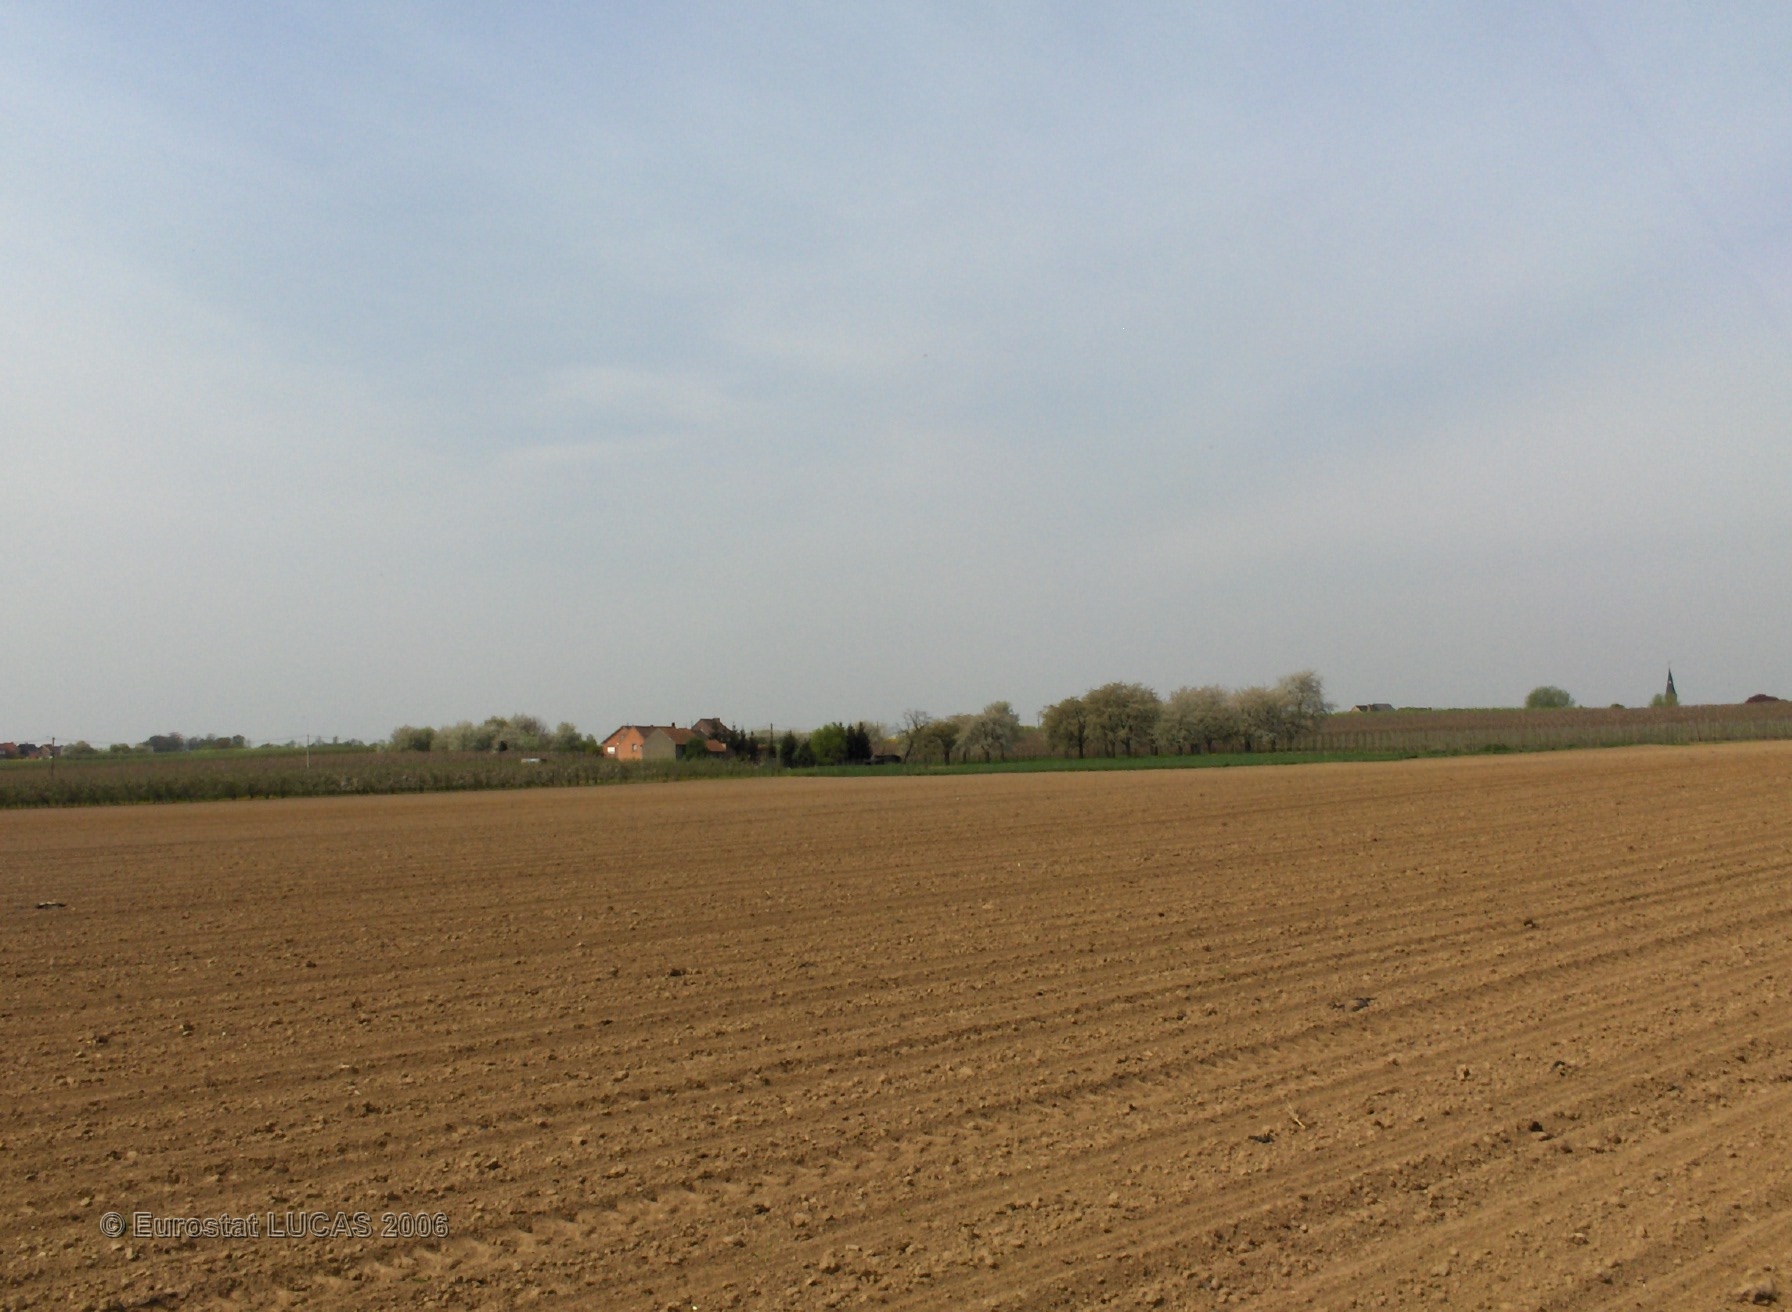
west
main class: Cropland
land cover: Maize
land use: Agriculture (excluding fallow land and kitchen gardens)
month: May
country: BE
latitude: 50.7326
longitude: 5.2229
